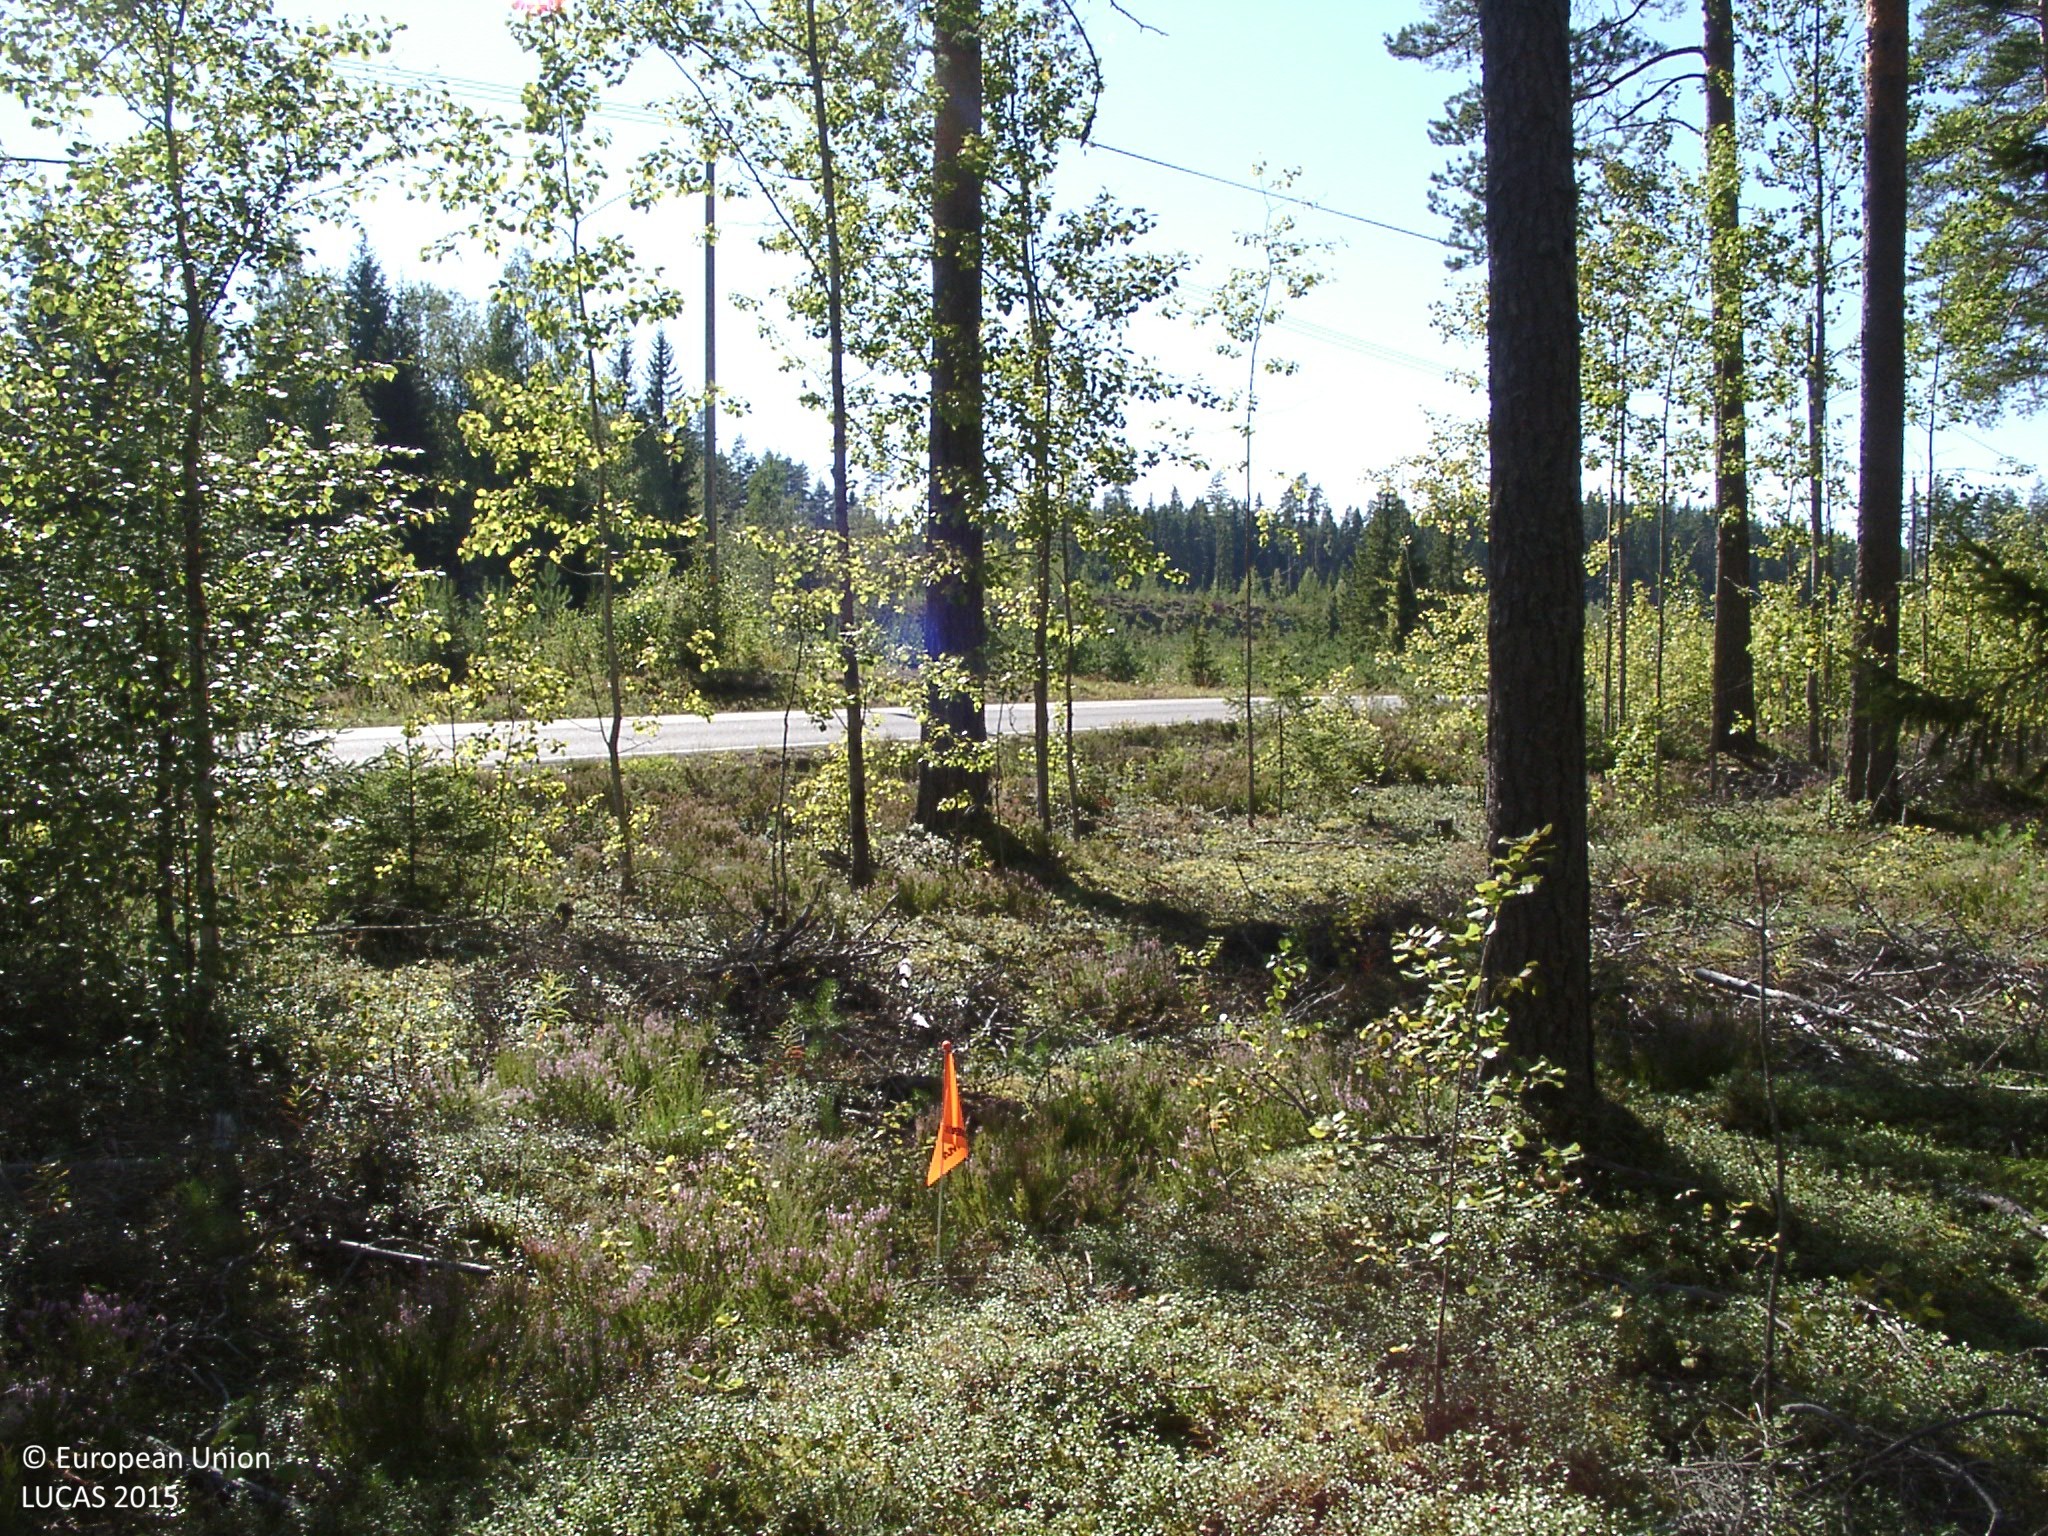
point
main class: Woodland
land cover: Pine dominated coniferous woodland
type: boreal forest
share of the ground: 50 - 75 %
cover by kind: coniferous forest trees 45 %, shrubs 30 %, broadleaved forest trees 10 %, lichens and mosses 10 %
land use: Forestry
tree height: > 5 m
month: August
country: FI
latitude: 61.8873
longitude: 25.0404
